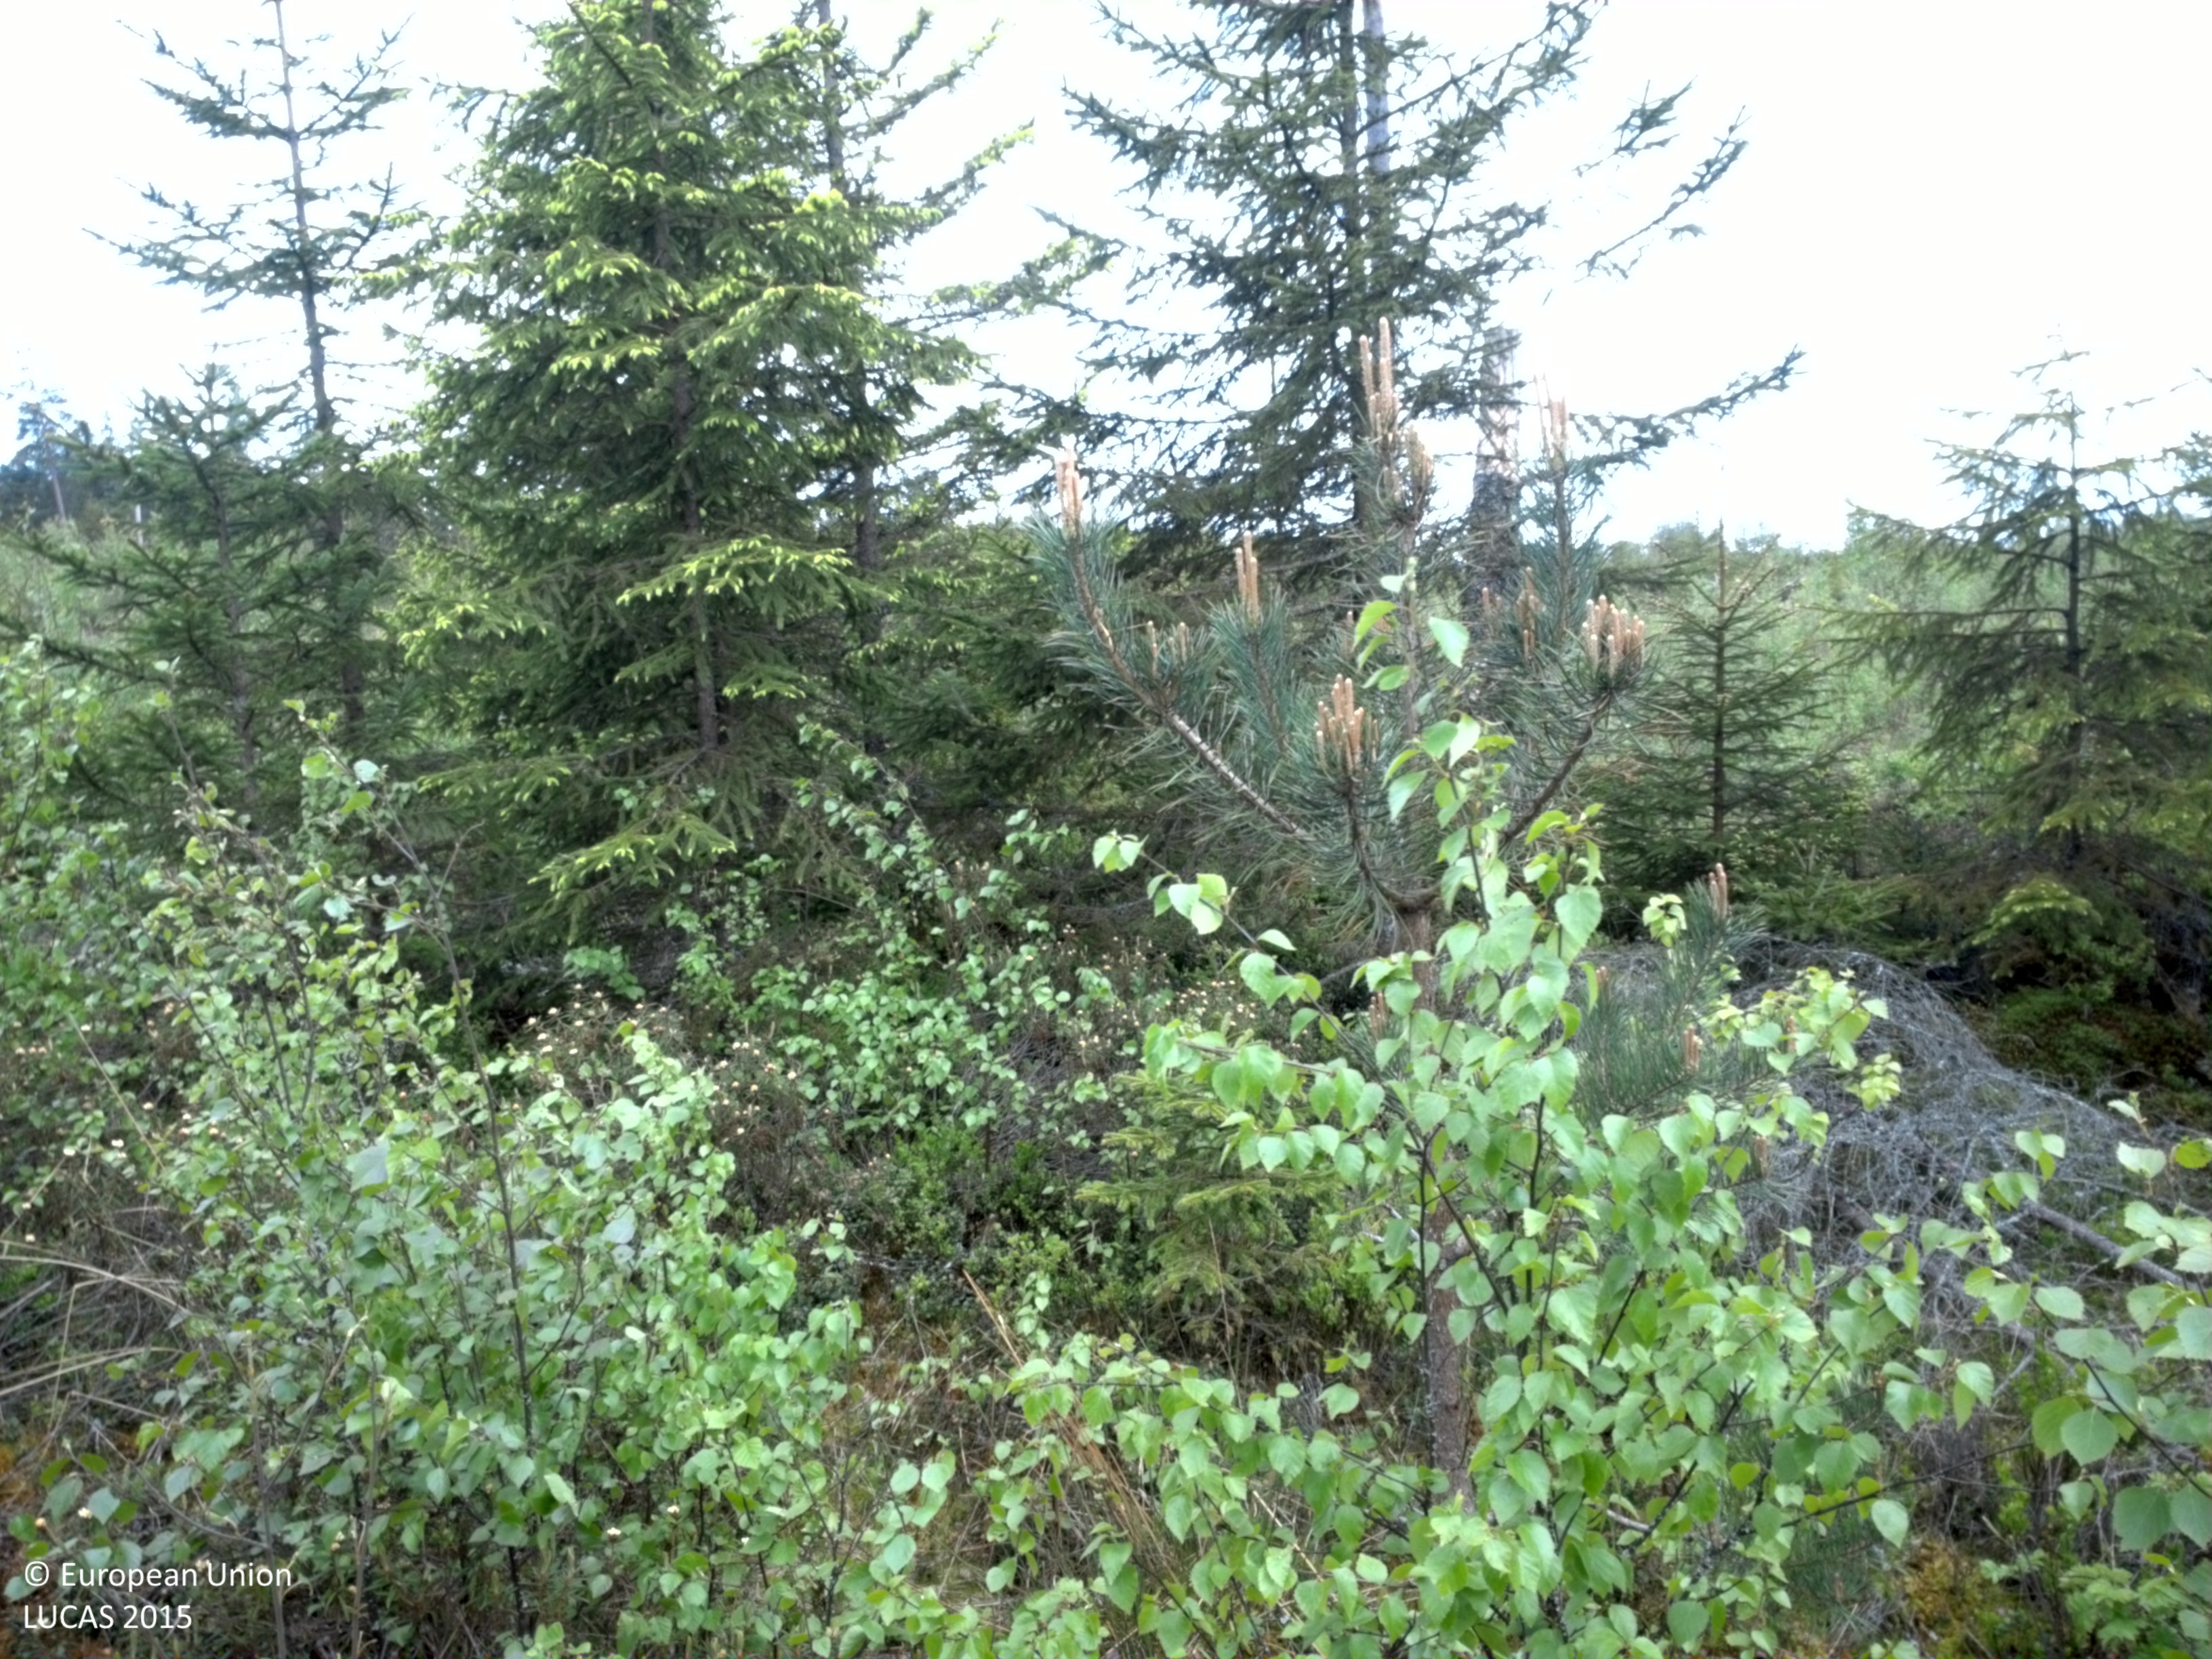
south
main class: Woodland
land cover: Spruce dominated mixed woodland
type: boreal forest
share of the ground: 50 - 75 %
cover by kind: coniferous forest trees 30 %, broadleaved forest trees 30 %, shrubs 20 %, herbaceous plants 10 %, lichens and mosses 10 %
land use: Forestry
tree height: > 5 m
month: June
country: SE
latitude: 56.8336
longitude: 14.3728
